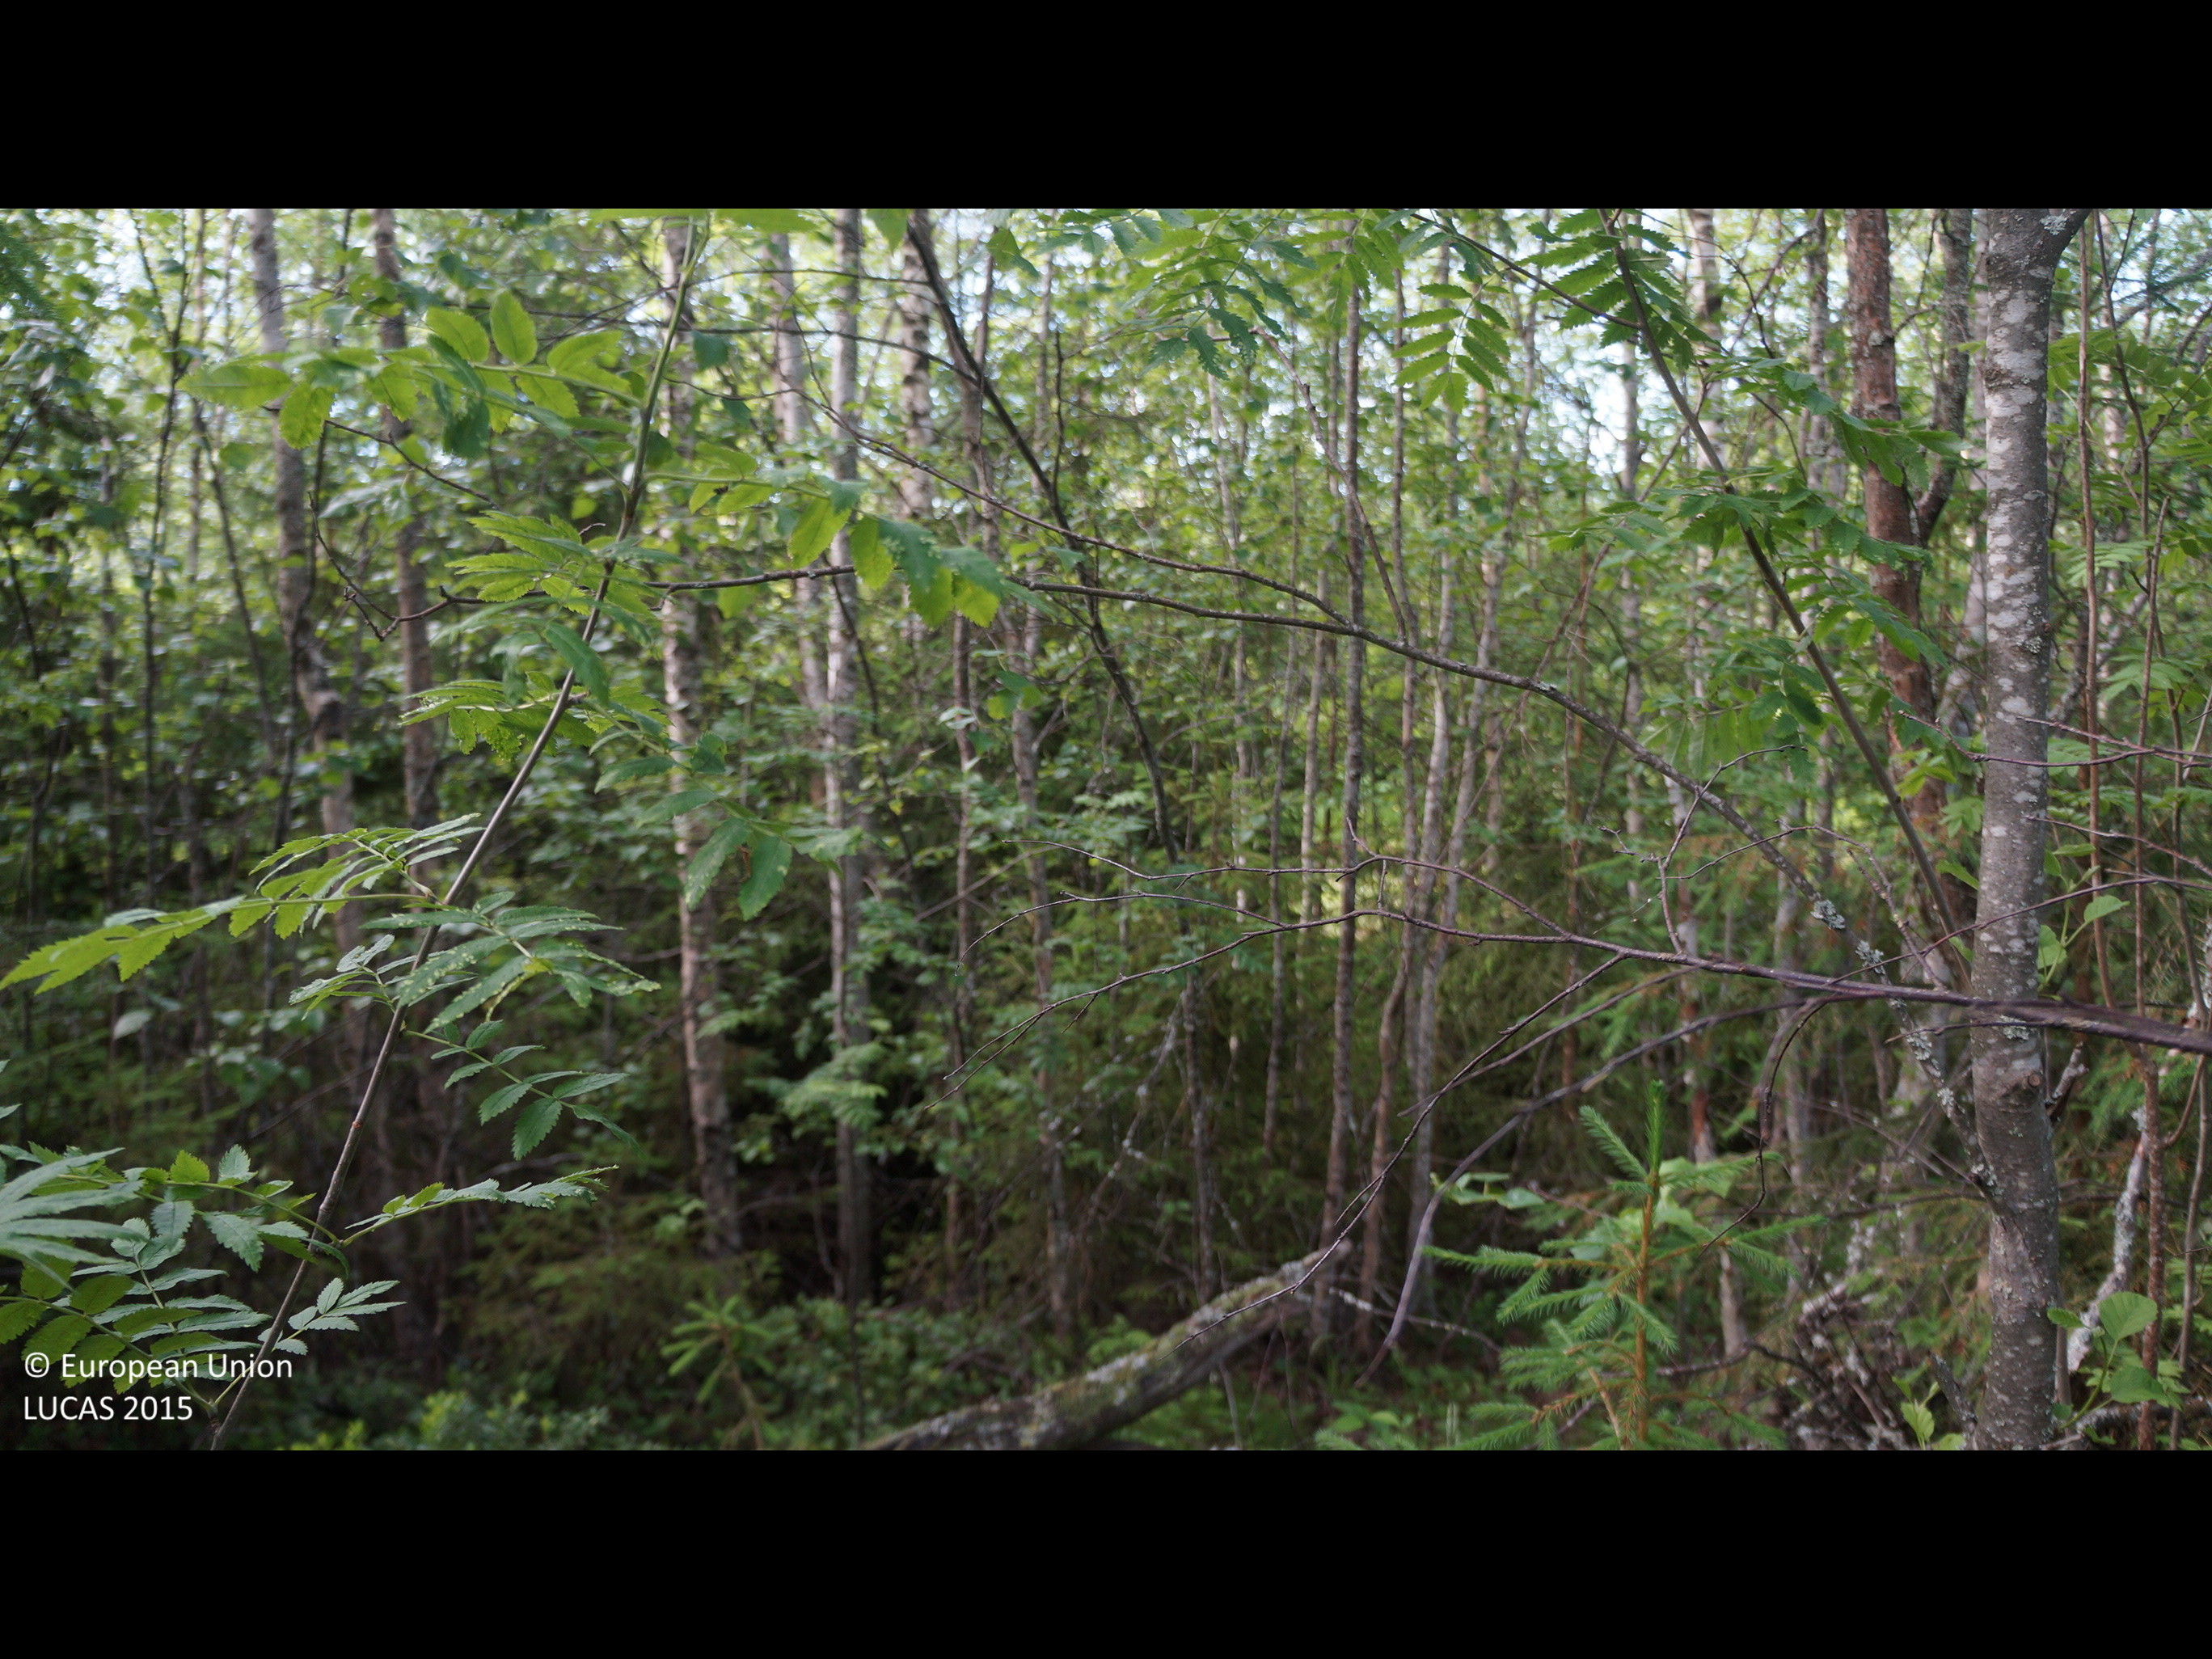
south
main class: Woodland
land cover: Broadleaved woodland
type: boreal forest
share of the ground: > 75 %
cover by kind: broadleaved forest trees 65 %, coniferous forest trees 15 %, shrubs 10 %, herbaceous plants 10 %
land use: Forestry
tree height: > 5 m
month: July
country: FI
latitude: 64.3185
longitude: 24.4859
